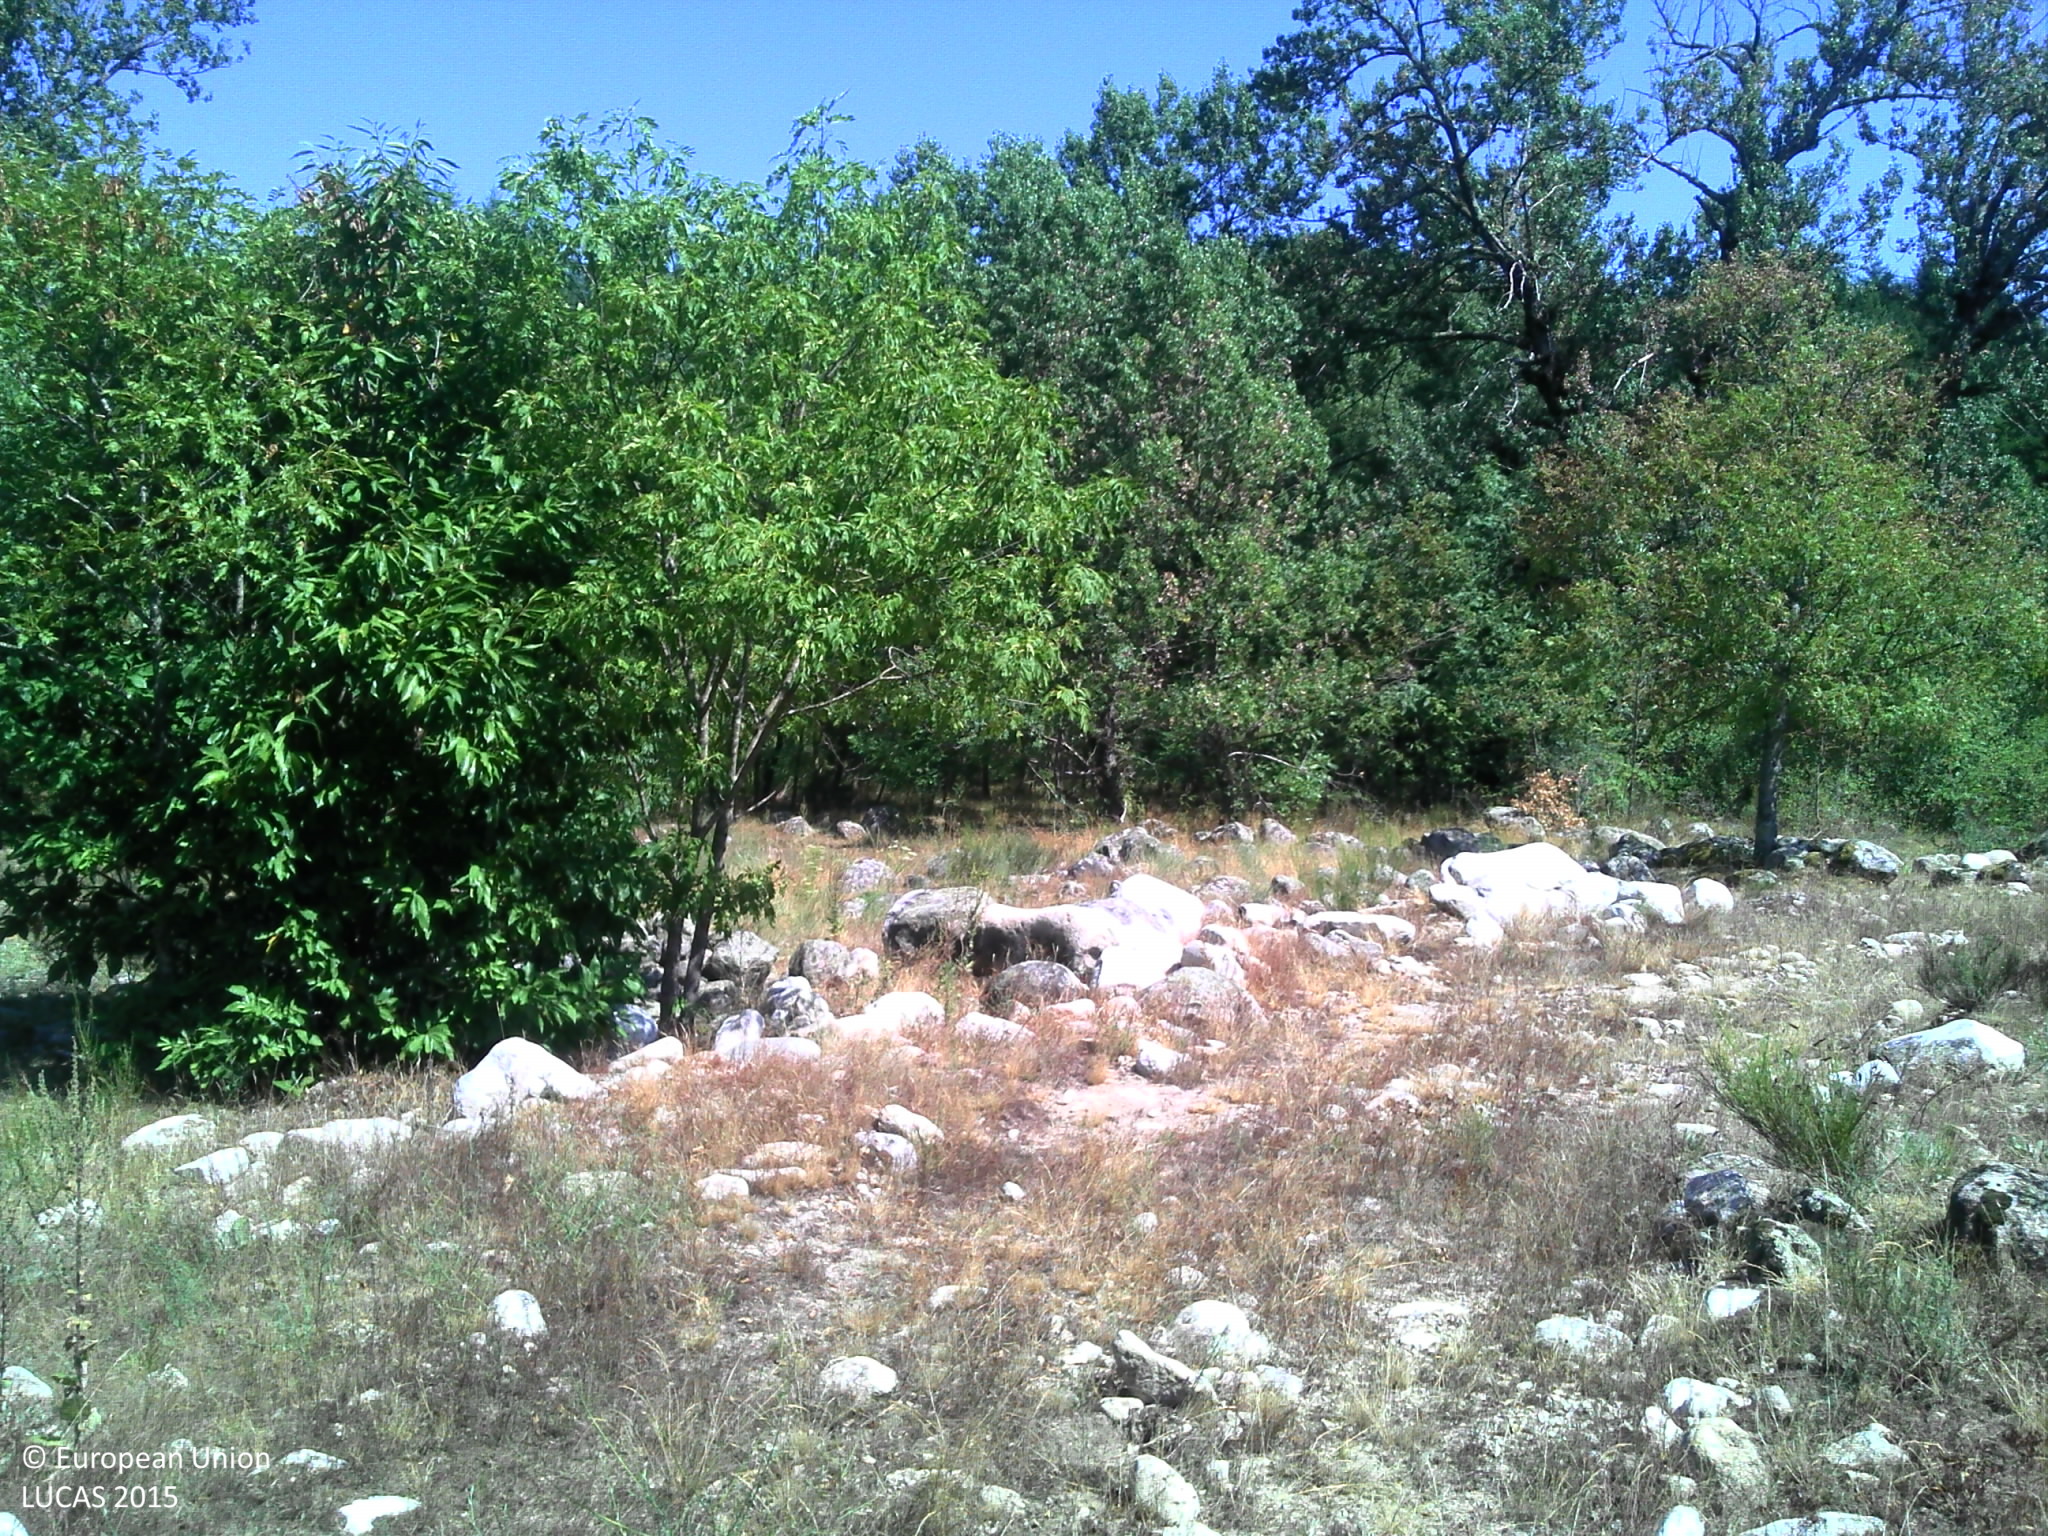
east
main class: Grassland
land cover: Grassland with sparse tree/shrub cover
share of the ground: > 75 %
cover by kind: herbaceous plants 85 %, broadleaved forest trees 5 %, shrubs 5 %
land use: Semi-natural and natural areas not in use
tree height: < 5 m
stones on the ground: 10 - 25 %
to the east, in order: Grassland with sparse tree/shrub cover; Broadleaved woodland; Rivers and streams; Fences; Grassland with sparse tree/shrub cover; Fences; Pine dominated mixed woodland; Ditches and canals; Broadleaved woodland
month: August
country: FR
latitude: 44.6233
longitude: 4.2210
